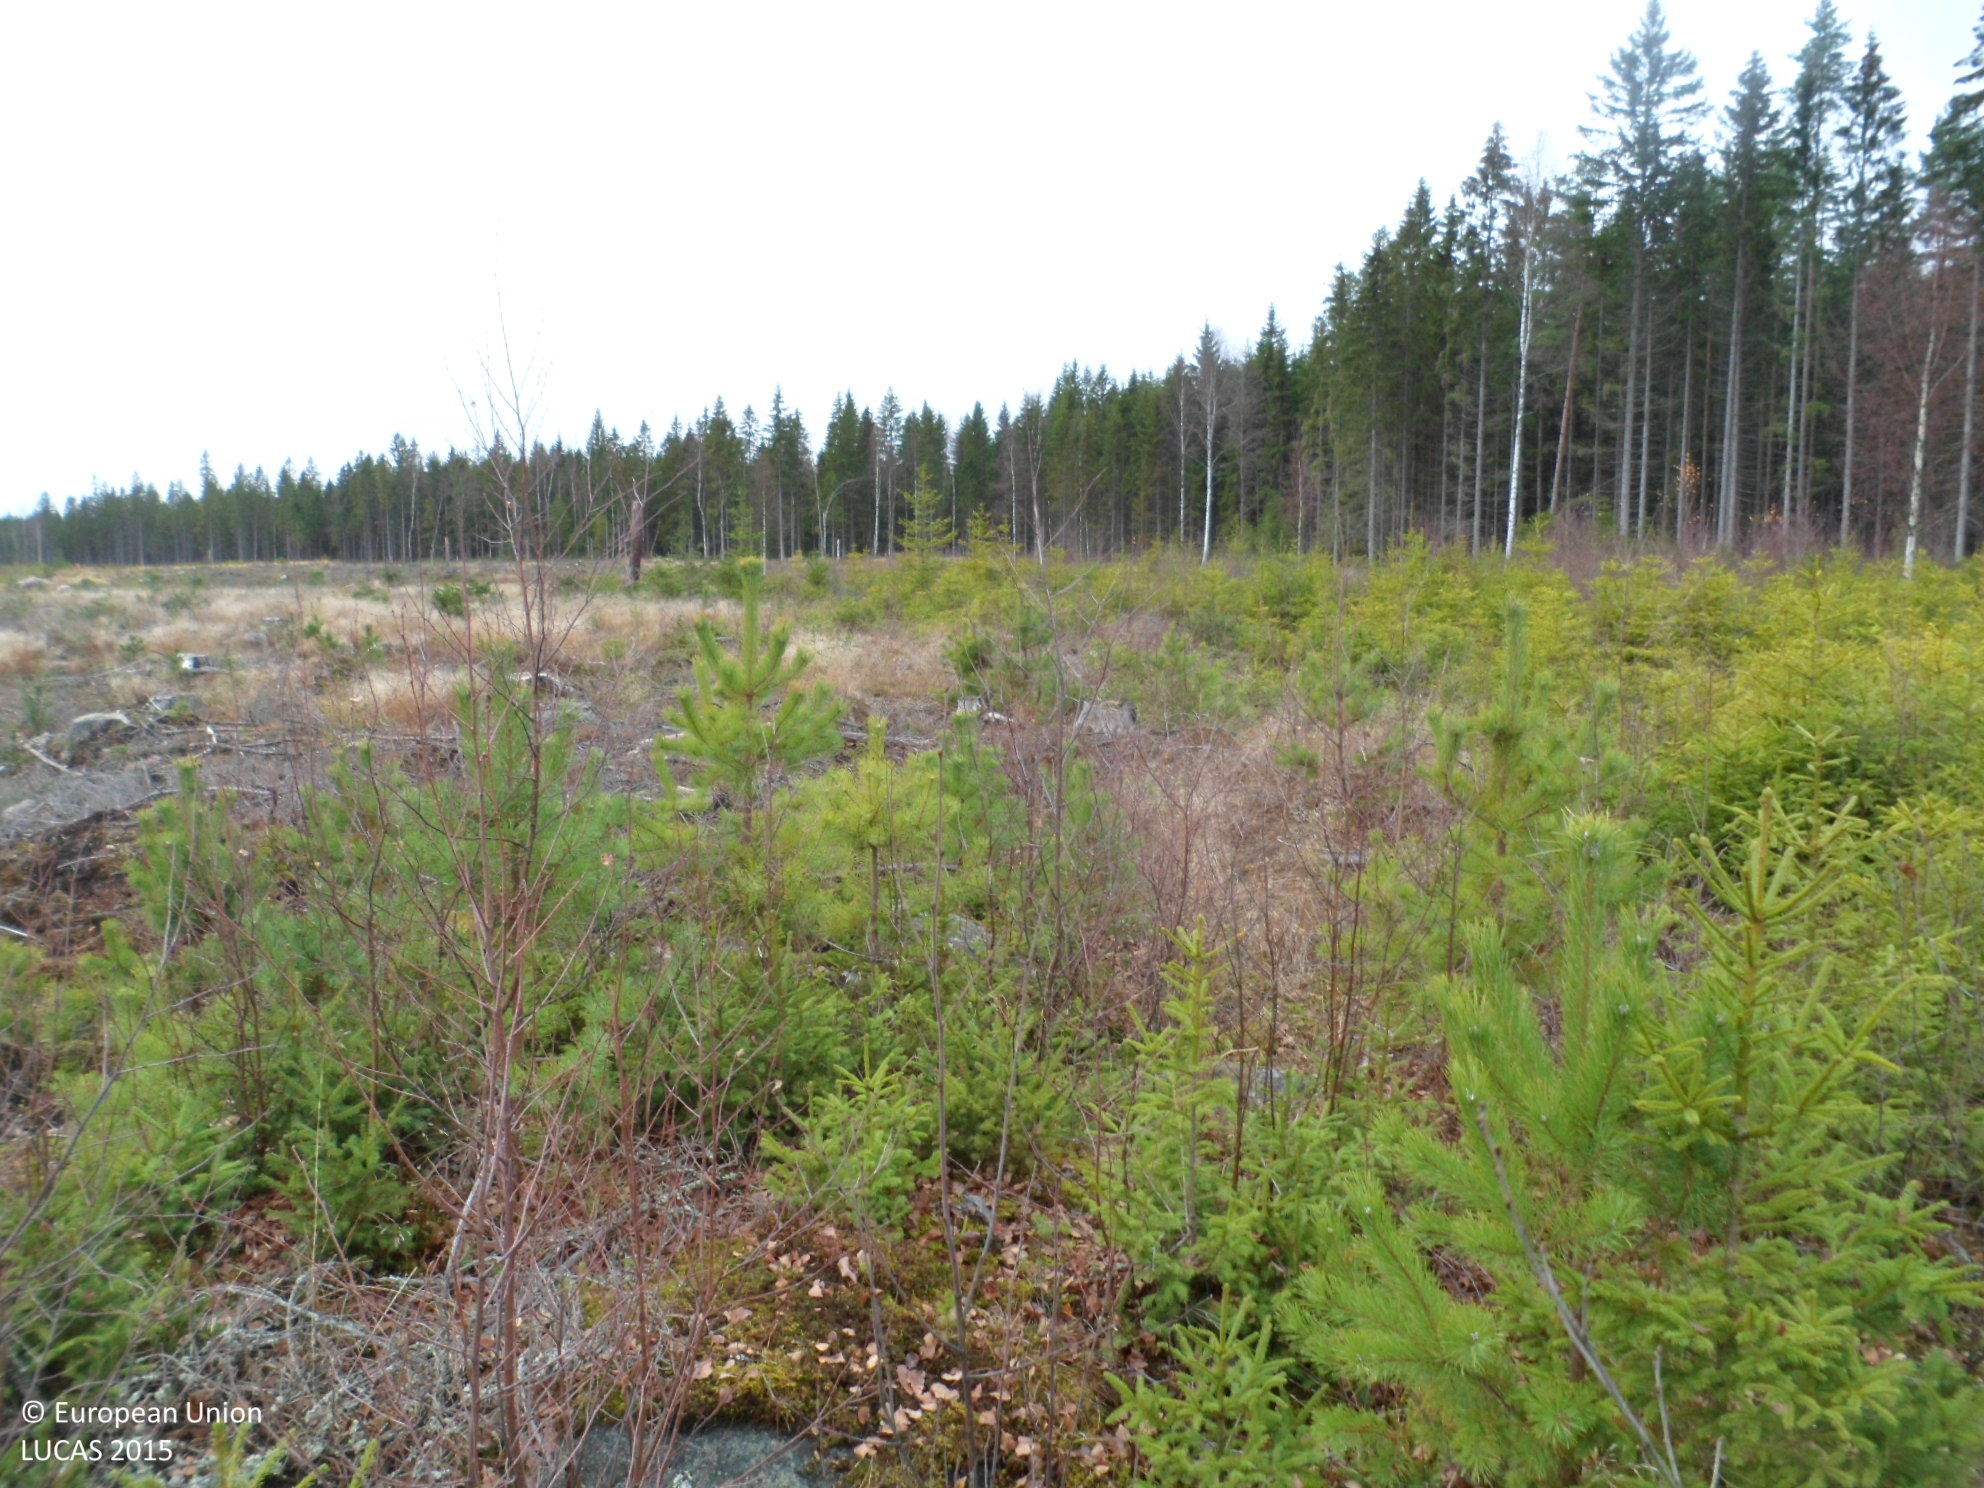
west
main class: Woodland
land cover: Spruce dominated mixed woodland
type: boreal forest
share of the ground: 50 - 75 %
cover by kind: coniferous forest trees 50 %, broadleaved forest trees 25 %, shrubs 10 %, lichens and mosses 10 %, herbaceous plants 5 %
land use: Forestry
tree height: < 5 m
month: November
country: SE
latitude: 56.7895
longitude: 15.9418
